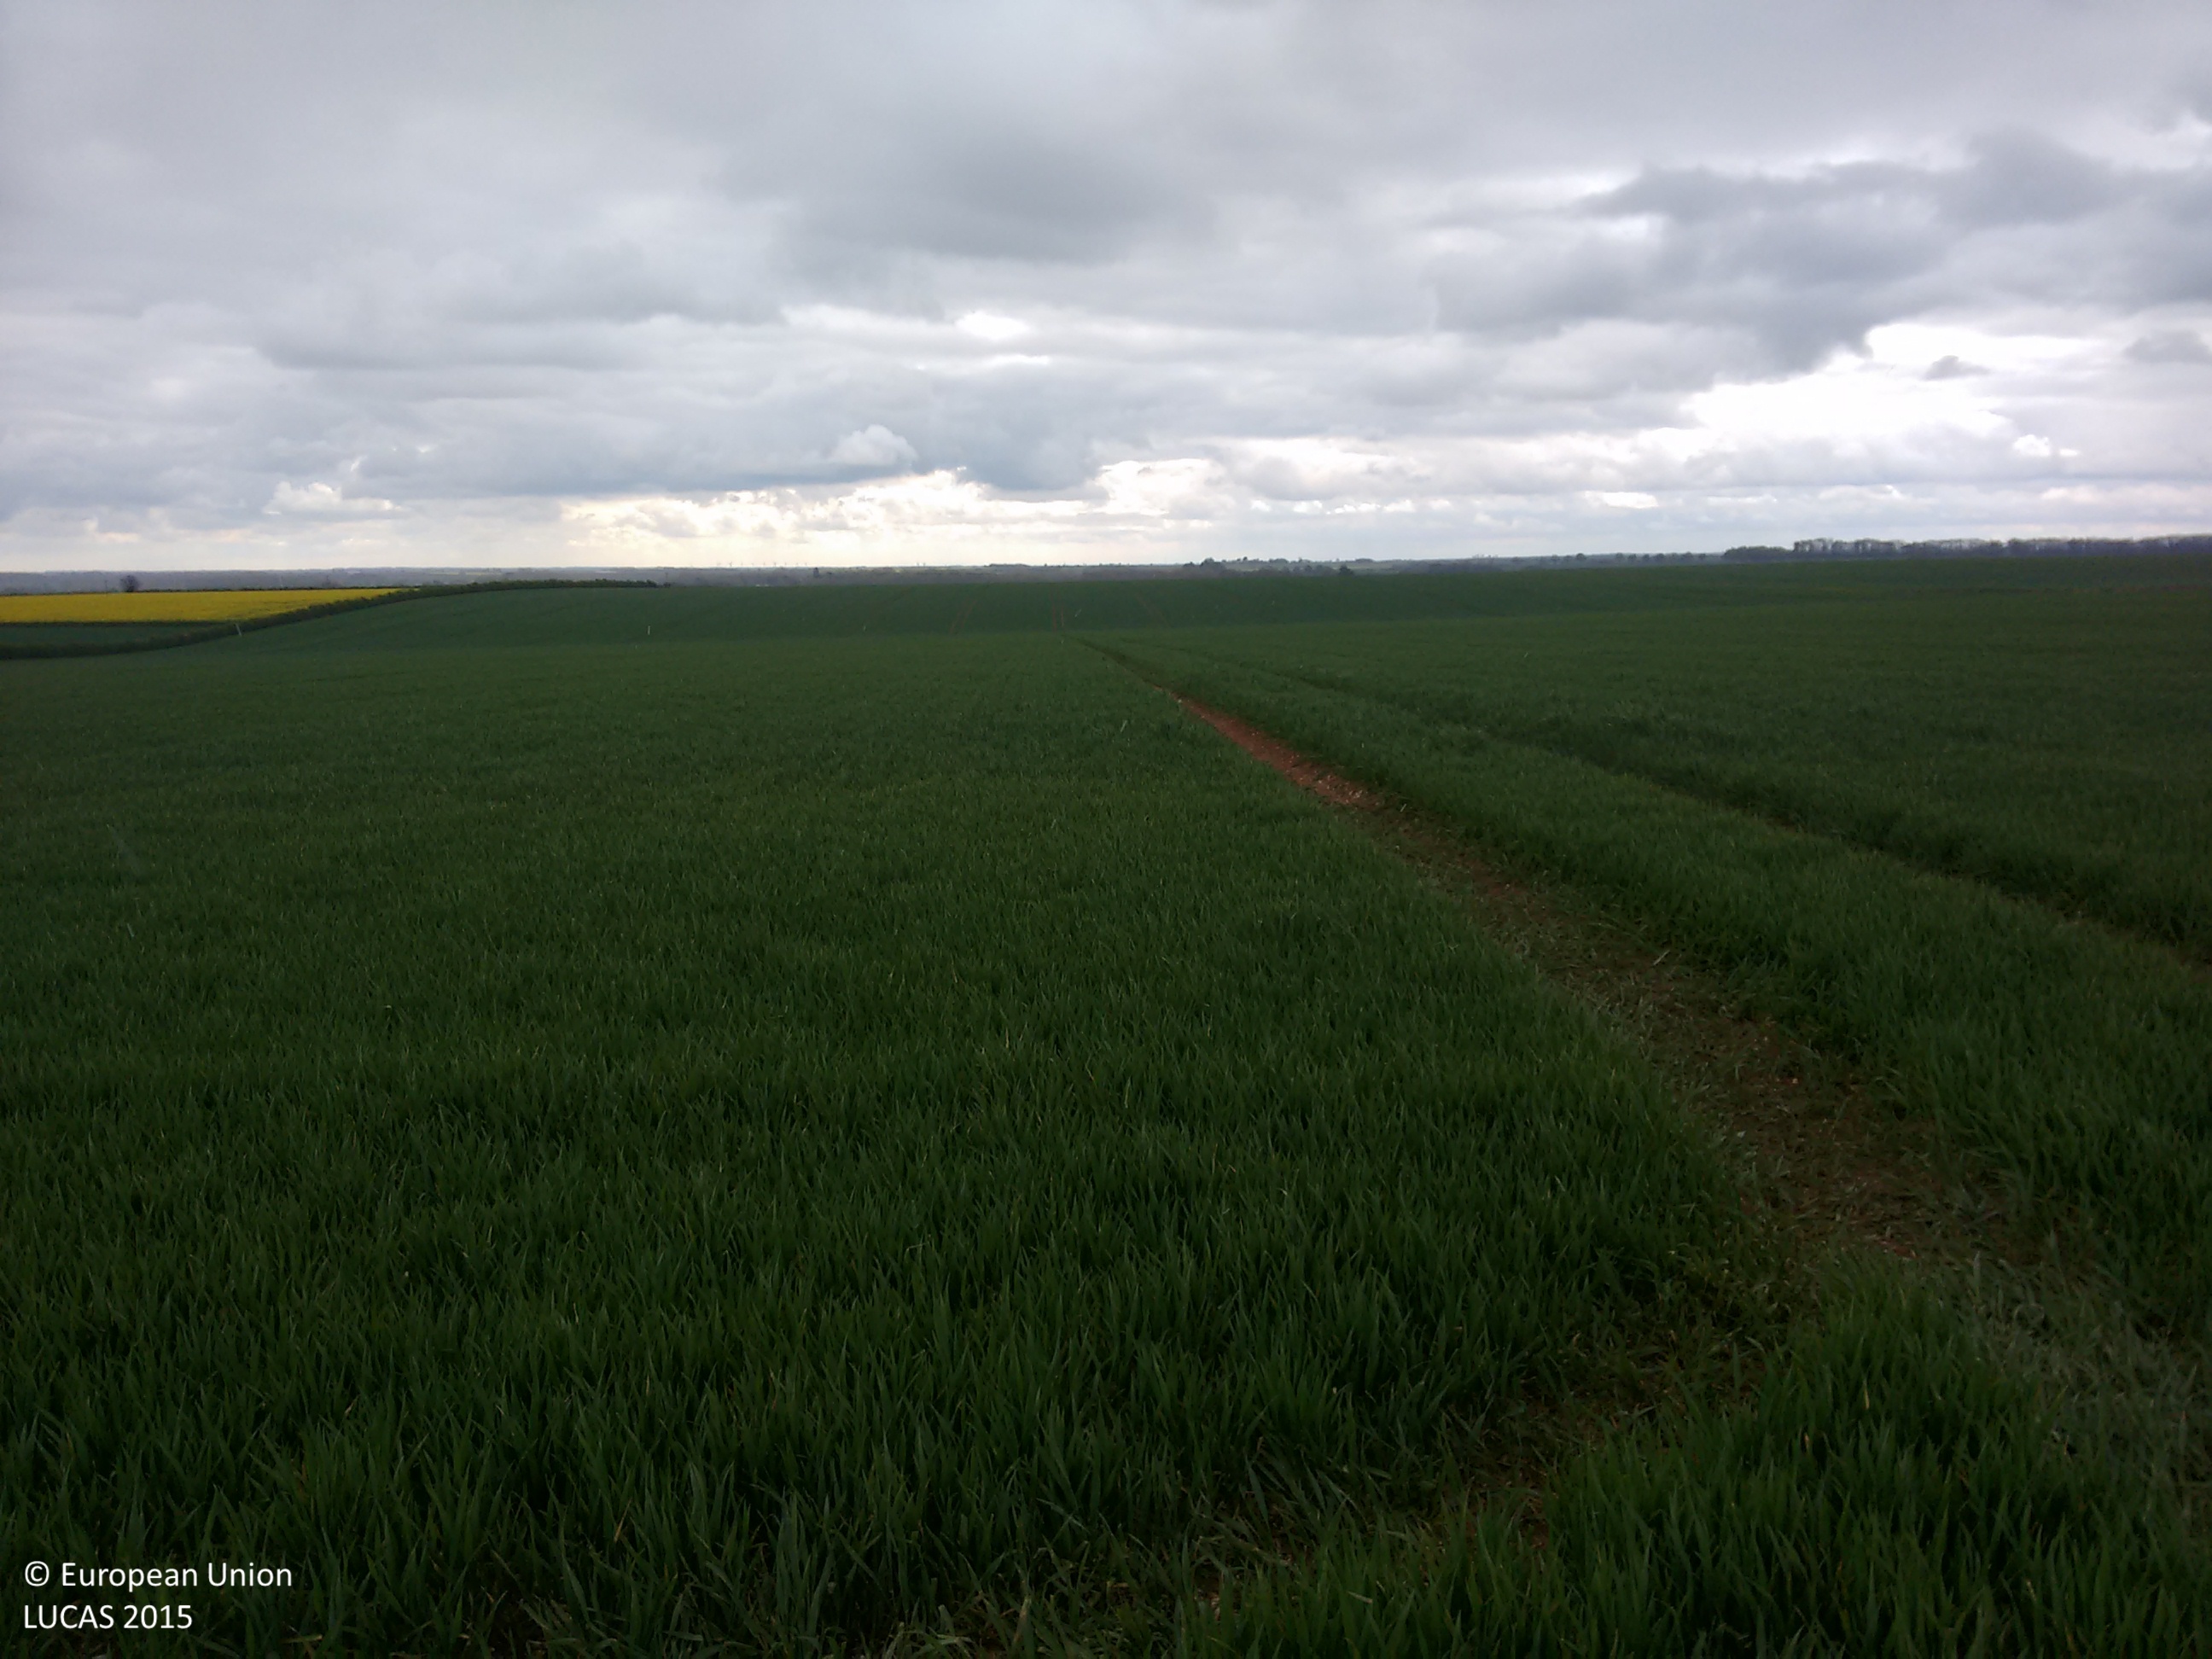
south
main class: Cropland
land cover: Common wheat
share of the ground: > 75 %
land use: Agriculture (excluding fallow land and kitchen gardens)
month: April
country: GB
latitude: 53.9947
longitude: -0.5160
